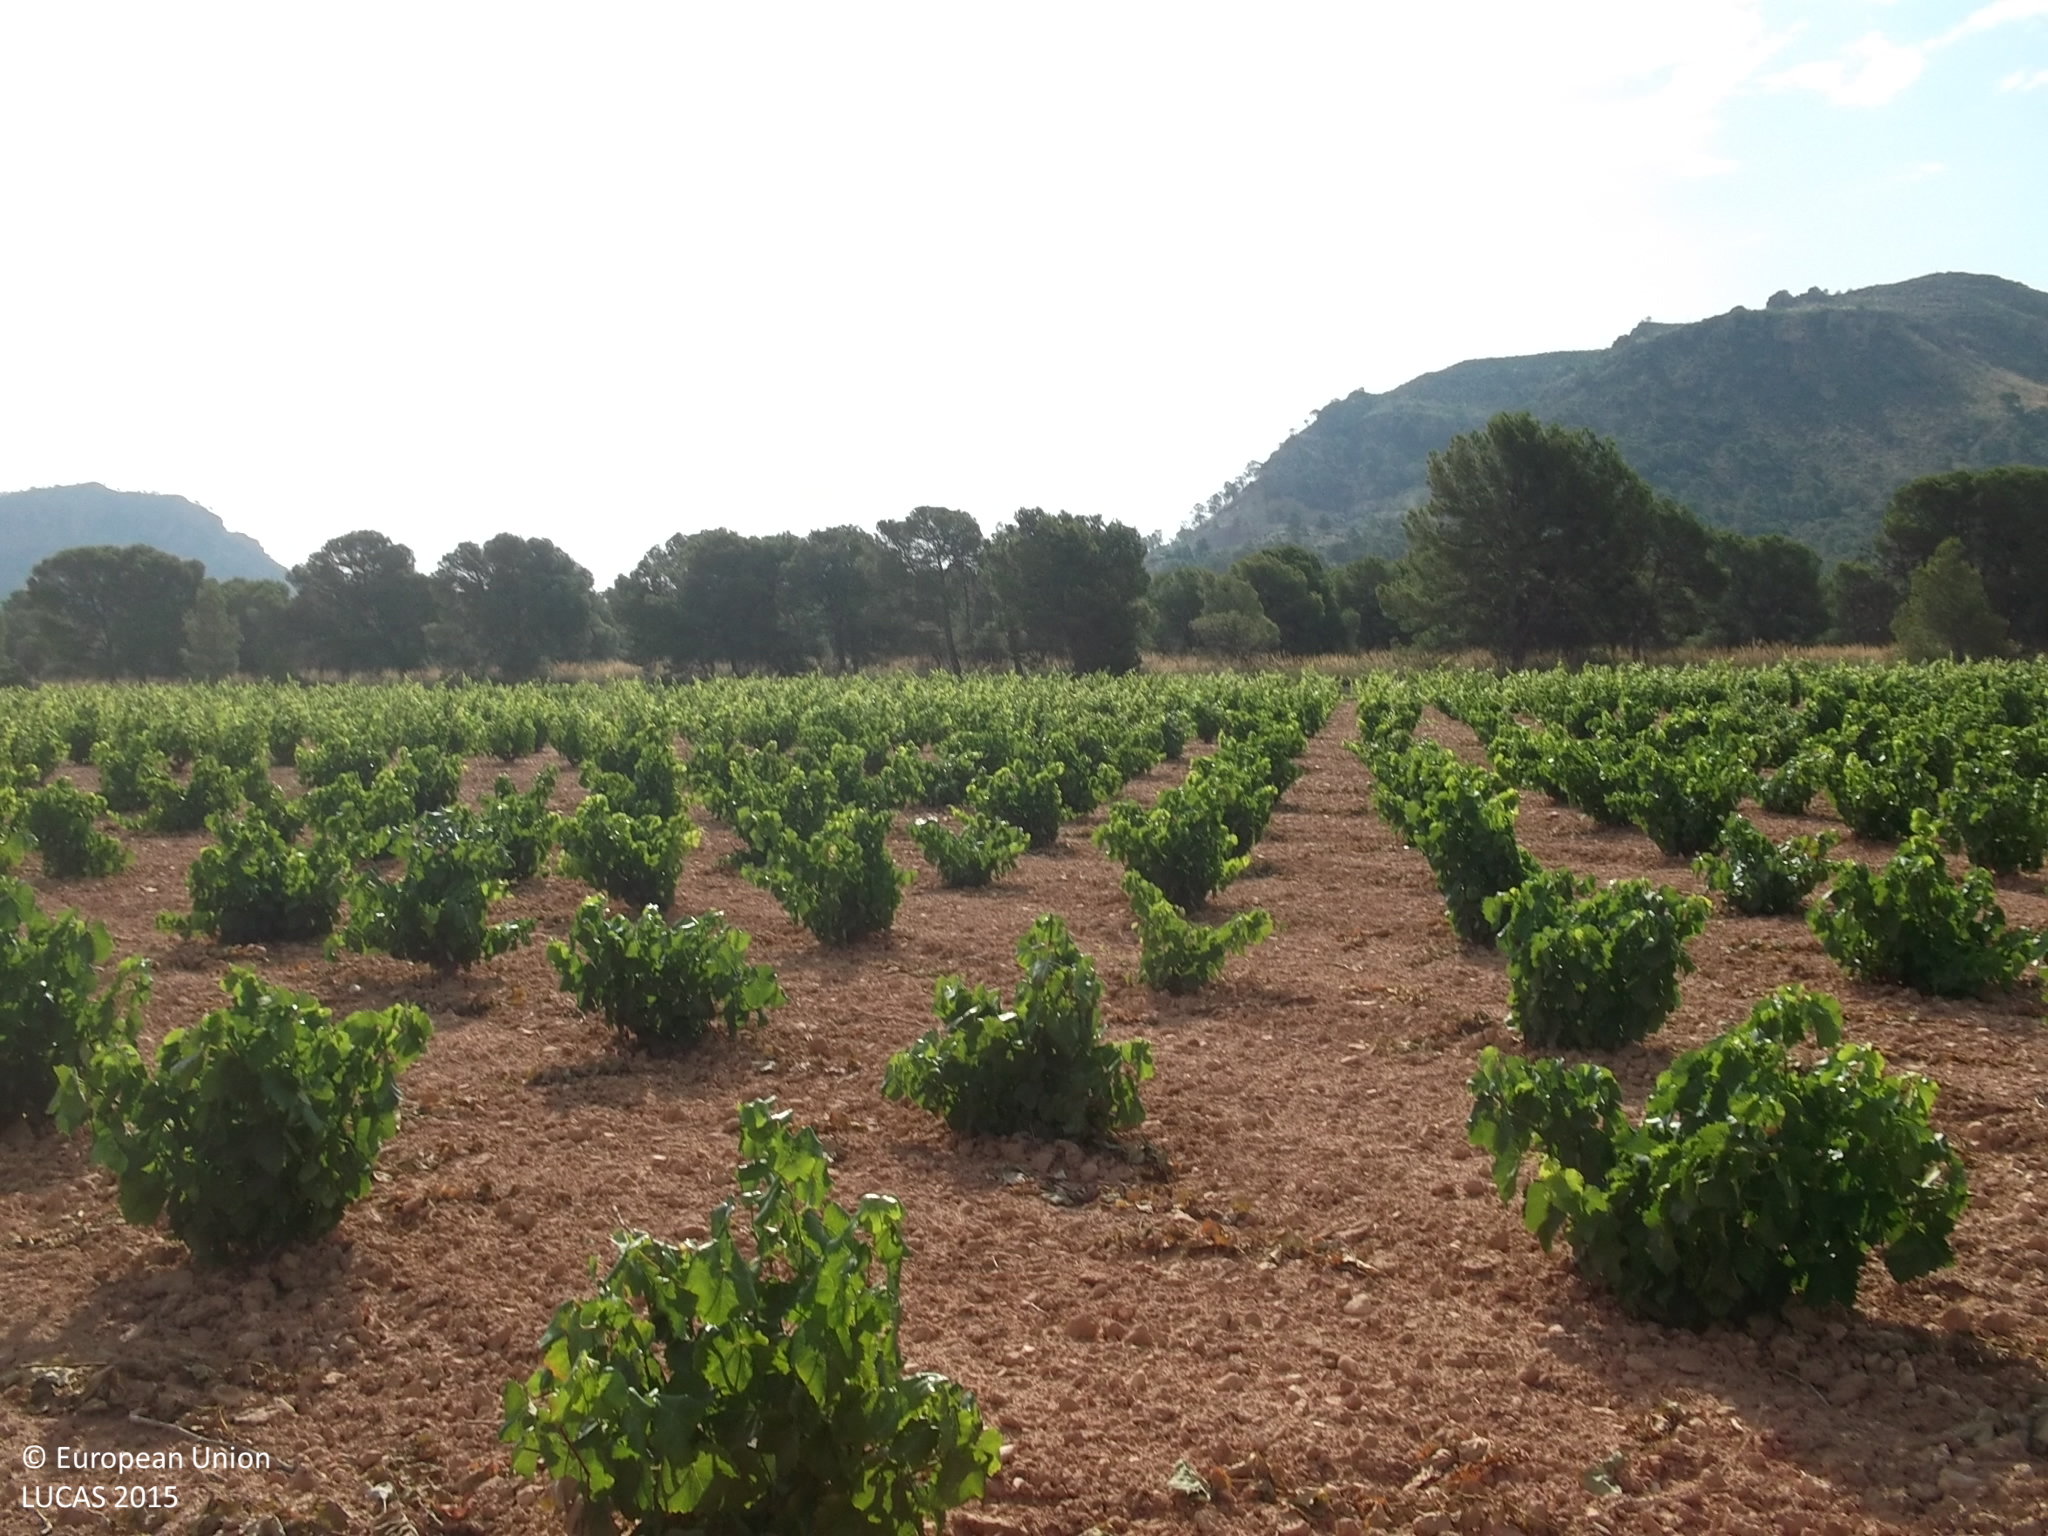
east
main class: Cropland
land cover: Vineyards
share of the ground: 10 - 25 %
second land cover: Other bare soil
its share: > 75 %
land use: Agriculture (excluding fallow land and kitchen gardens)
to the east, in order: Vineyards; Other bare soil; Tracks; Pine dominated coniferous woodland
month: June
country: ES
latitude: 38.3627
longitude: -1.5152
